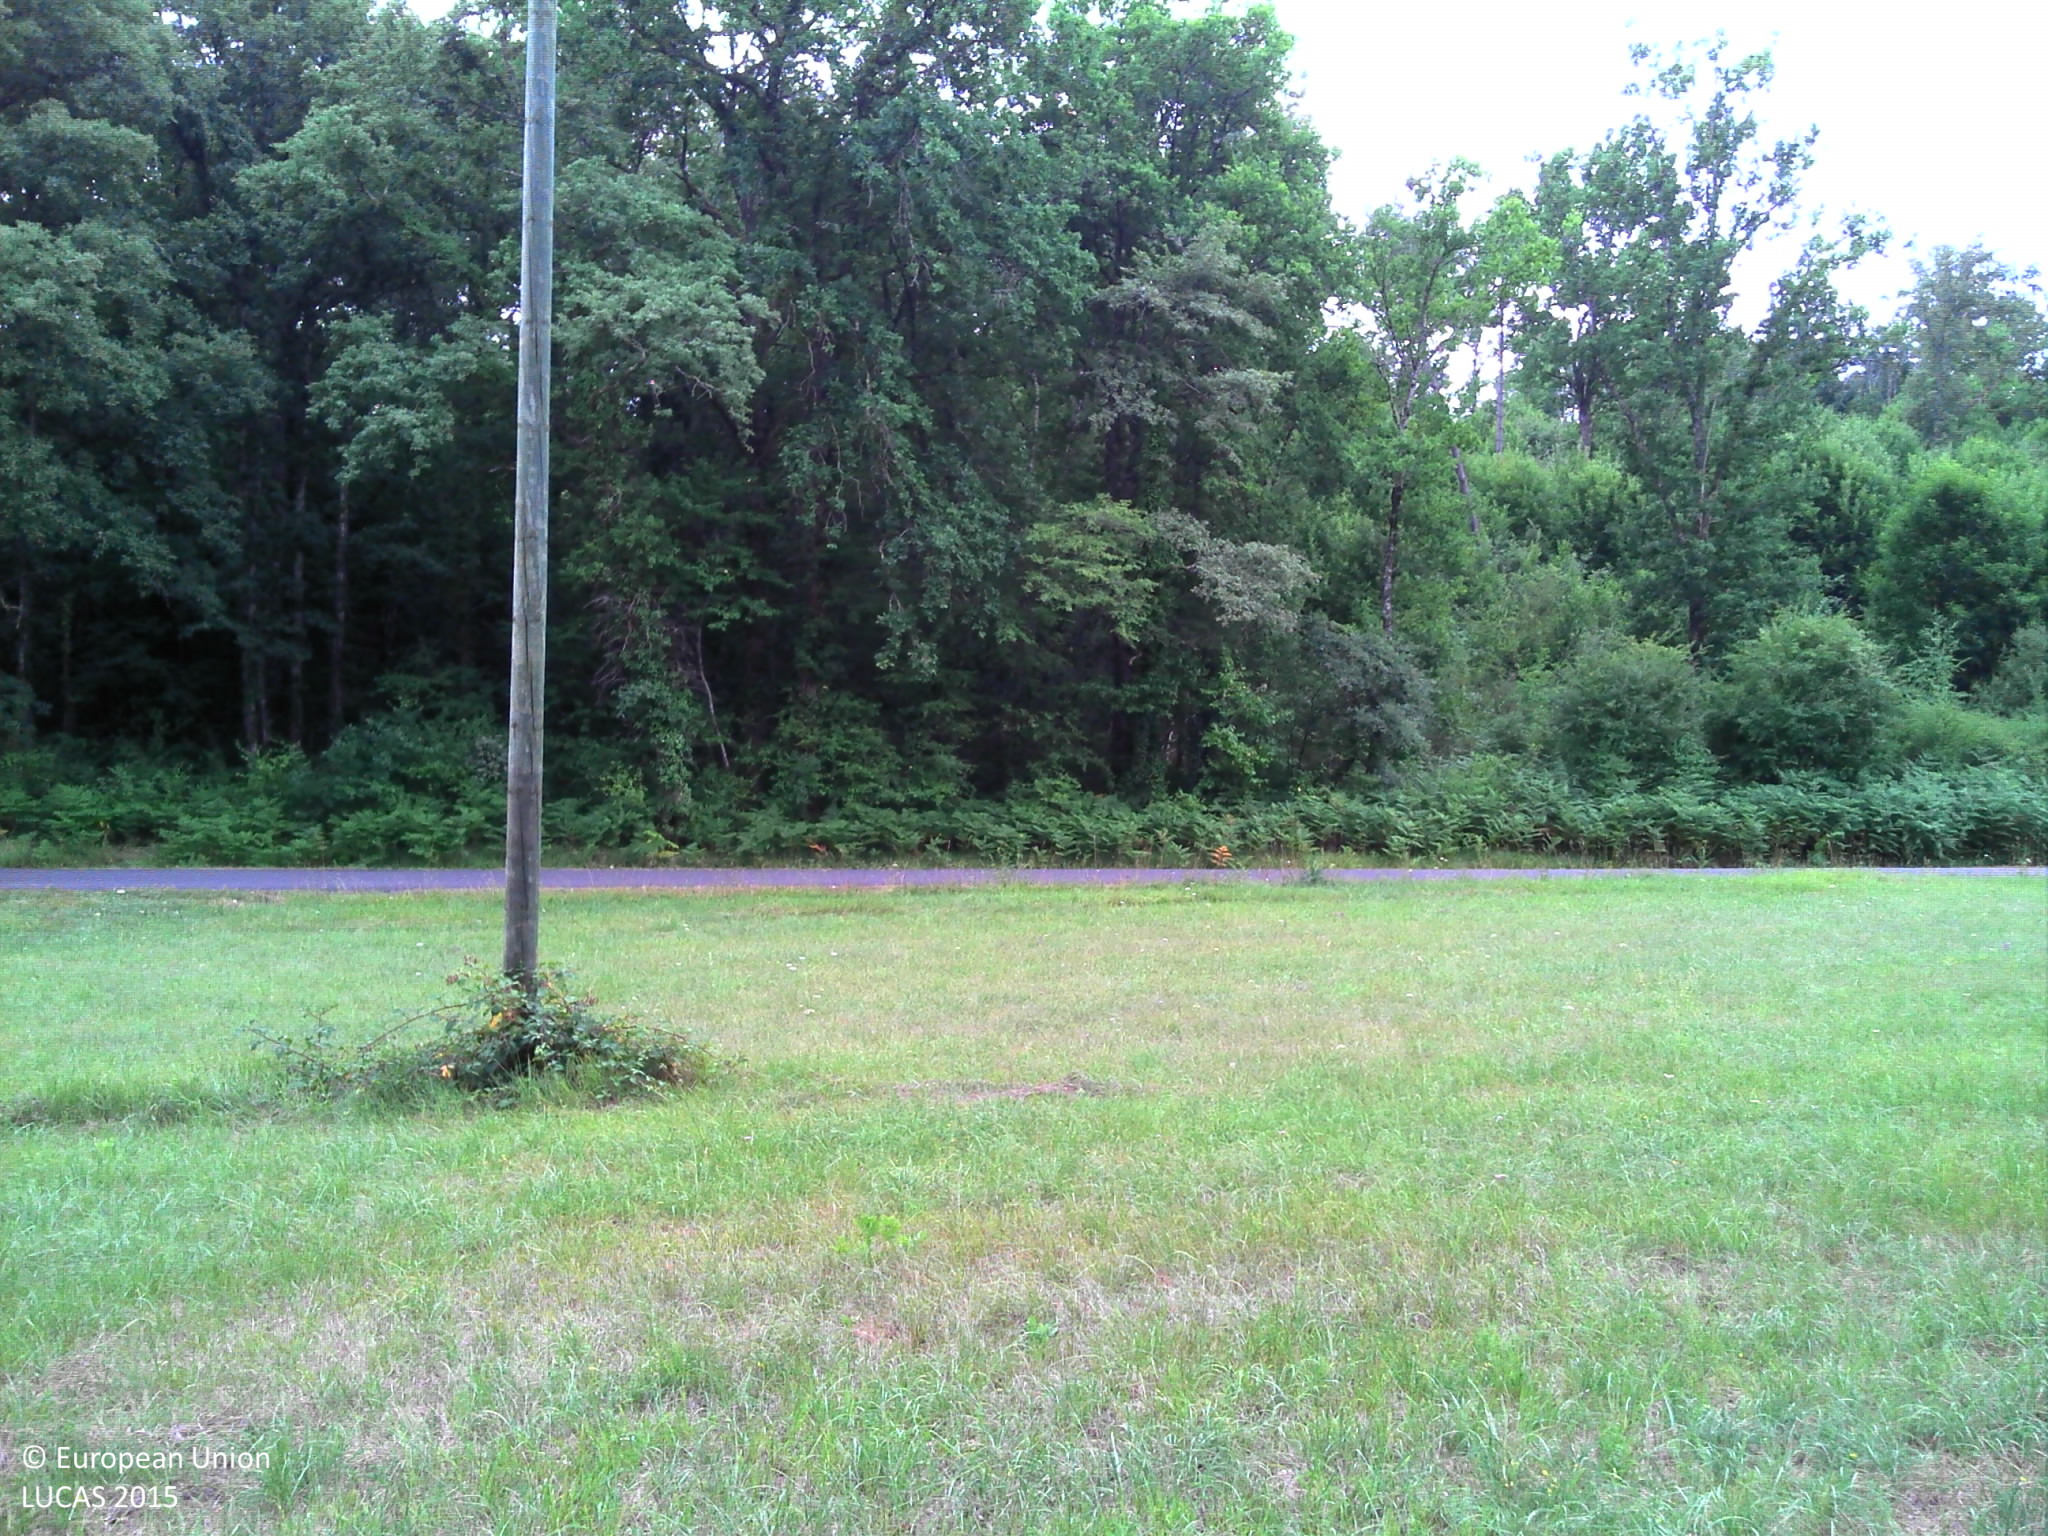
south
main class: Woodland
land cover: Broadleaved woodland
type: acidophilous oak and oak-birch forest
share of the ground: > 75 %
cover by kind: broadleaved forest trees 65 %, herbaceous plants 20 %, shrubs 15 %
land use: Forestry
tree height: > 5 m
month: July
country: FR
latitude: 45.0464
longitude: 0.7866
